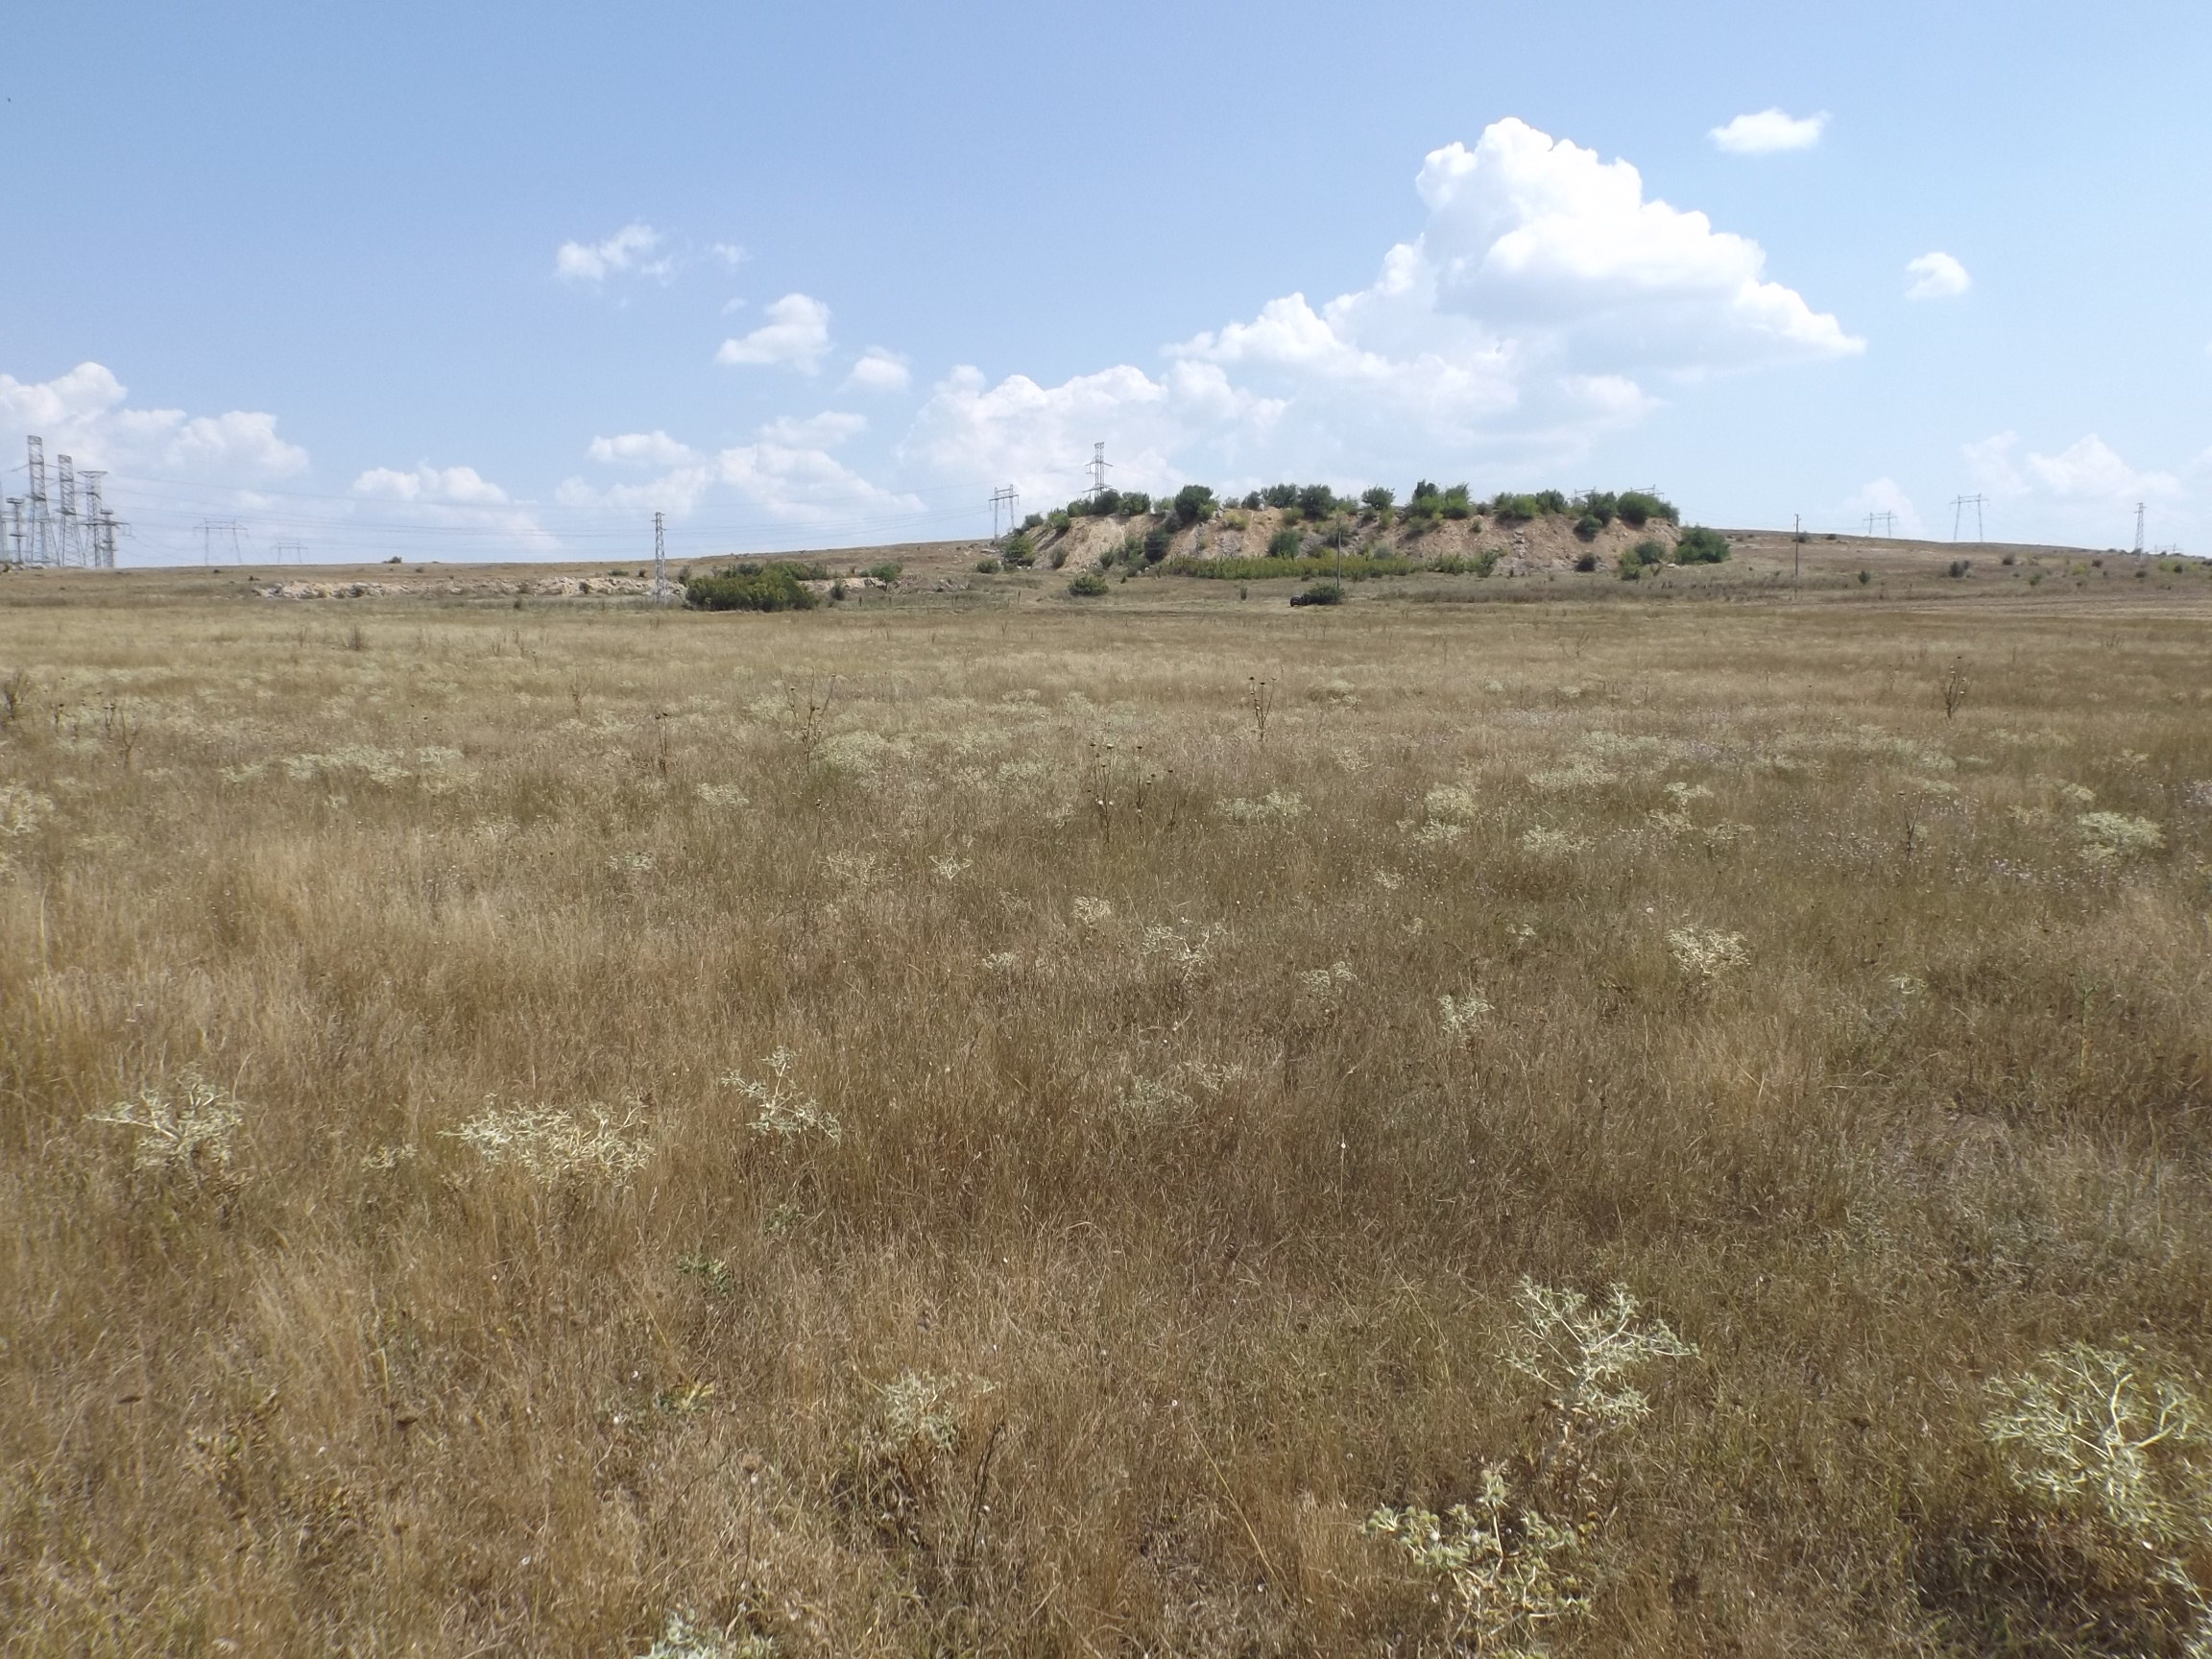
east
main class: Grassland
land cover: Grassland without tree/shrub cover
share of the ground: > 75 %
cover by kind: herbaceous plants 100 %
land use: Semi-natural and natural areas not in use
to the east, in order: Grassland without tree/shrub cover; Single bushes/trees; Paved roads, cycling and walking lanes; Grassland with sparse tree/shrub cover; Electric lines; Grassland without tree/shrub cover
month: August
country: BG
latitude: 43.3098
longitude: 27.5000
